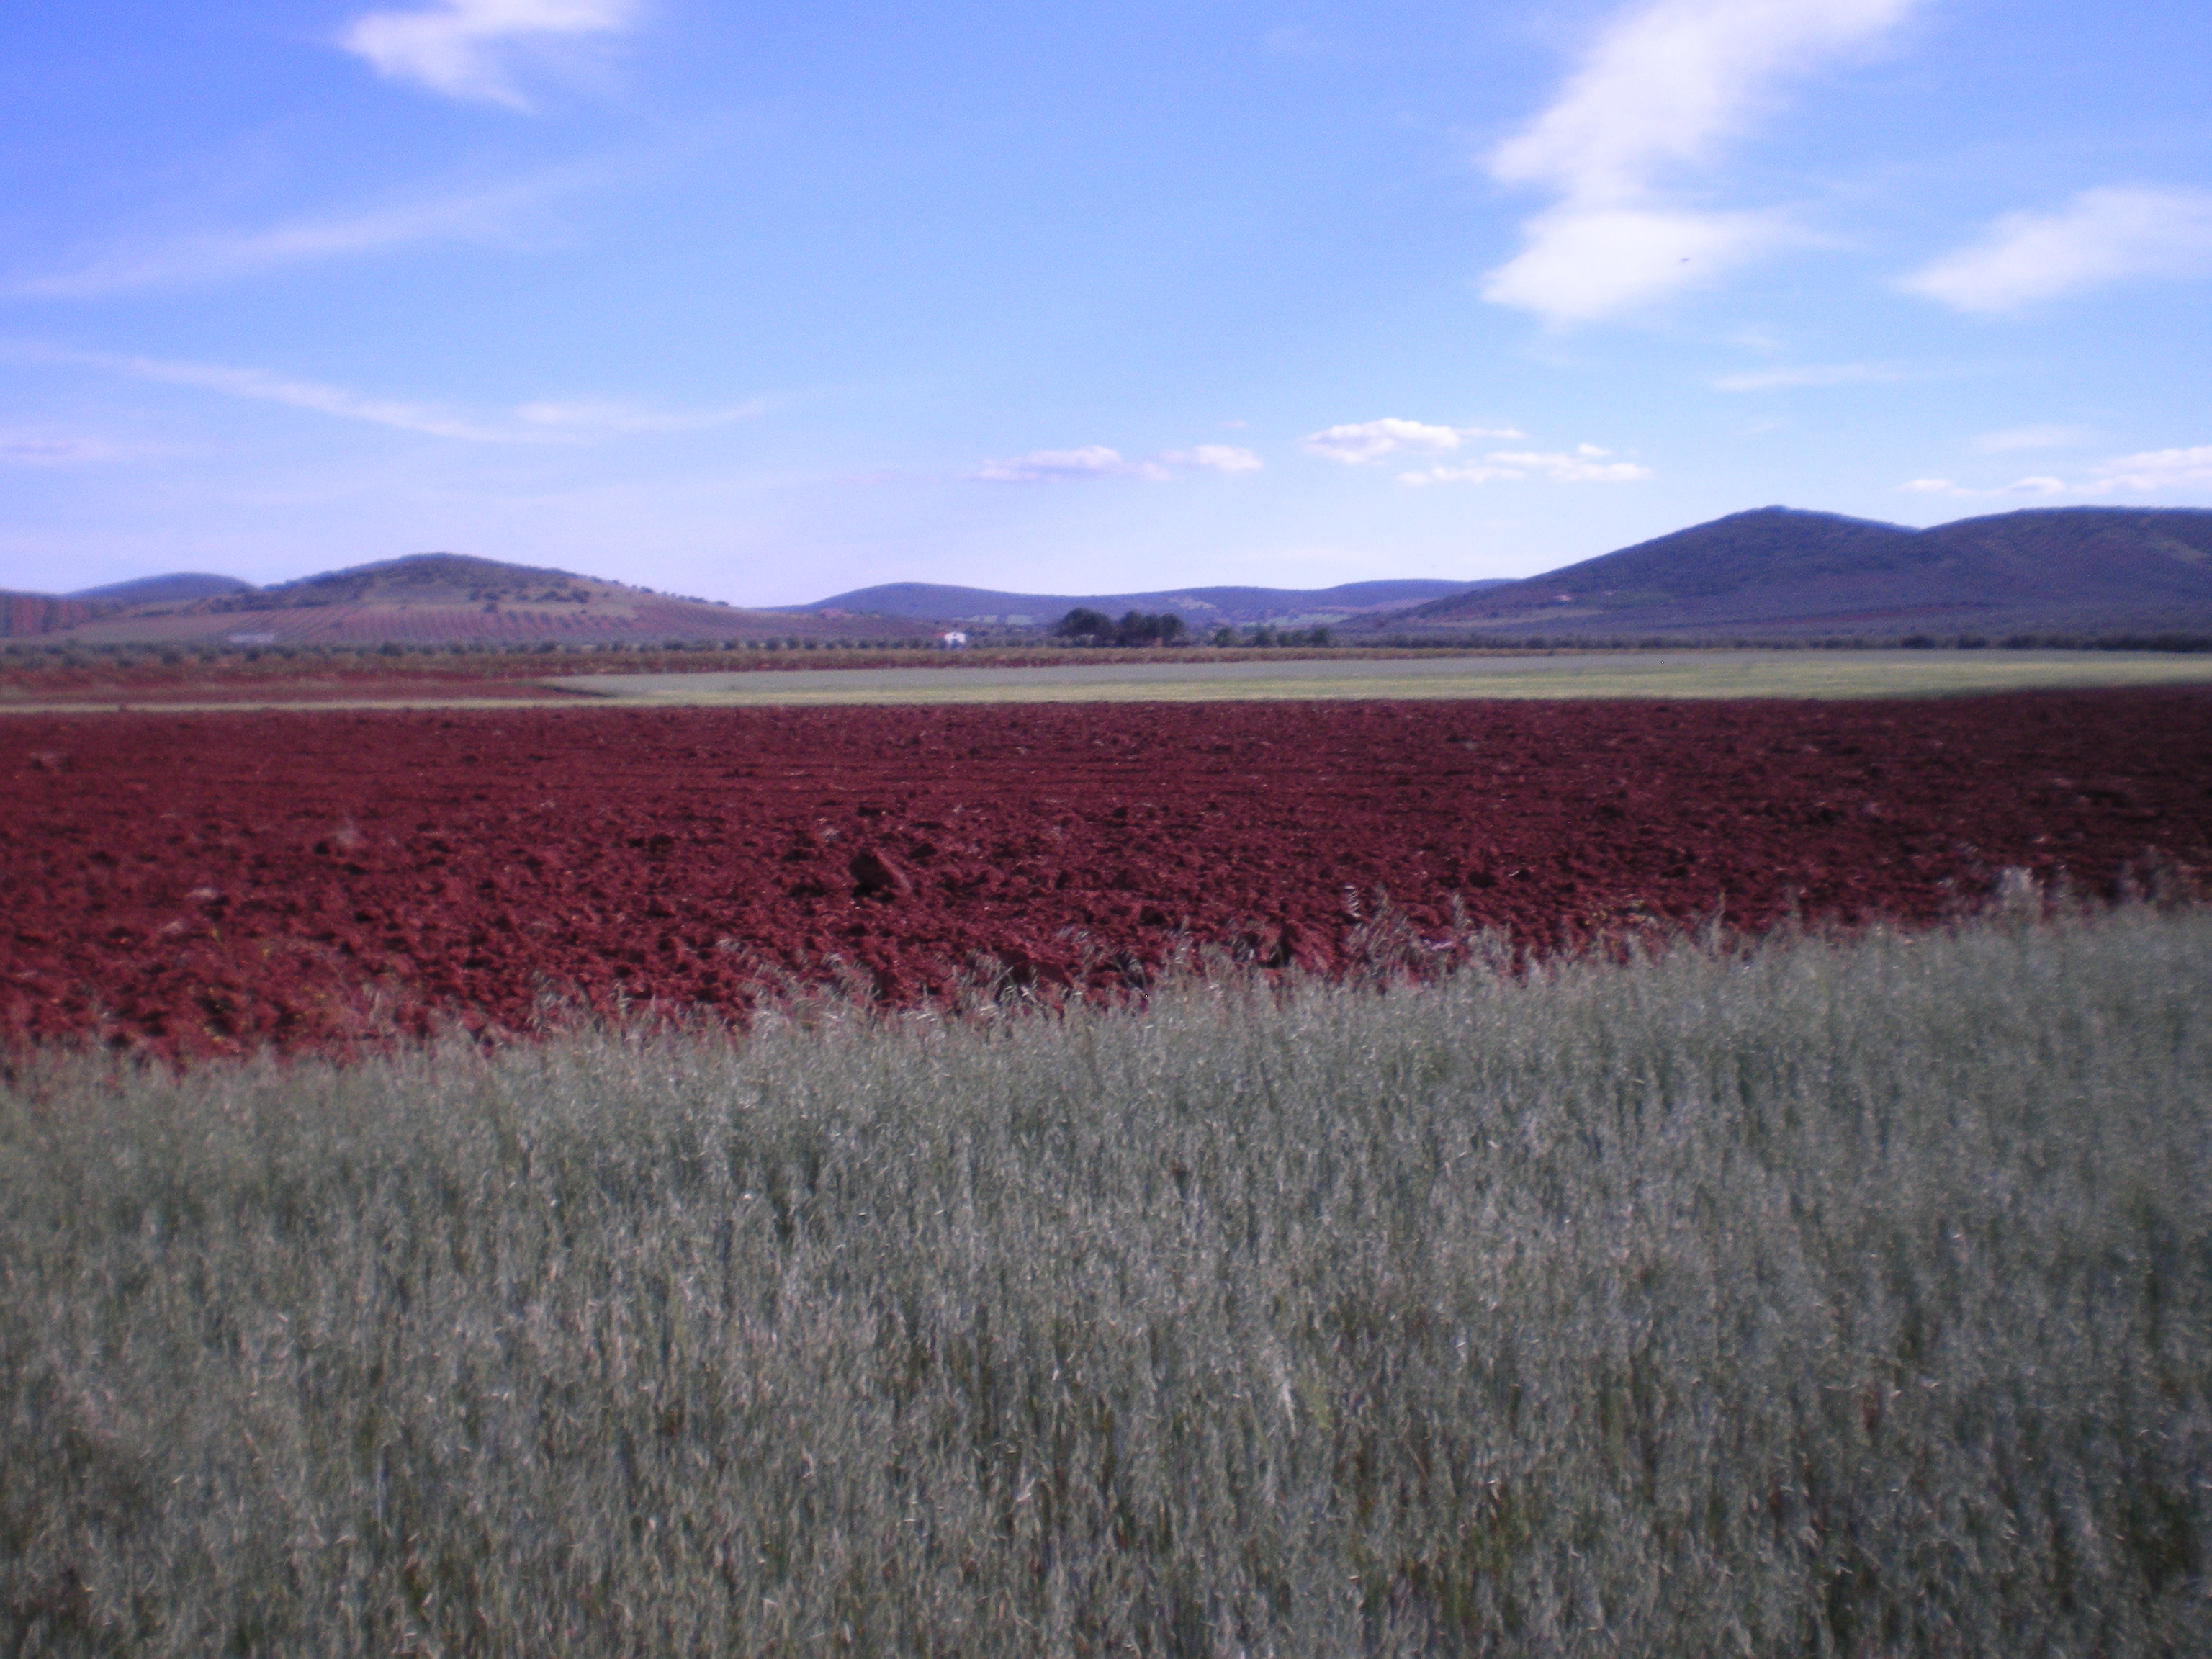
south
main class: Cropland
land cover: Oats
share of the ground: > 75 %
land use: Agriculture (excluding fallow land and kitchen gardens)
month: April
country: ES
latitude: 38.6186
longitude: -3.3429
